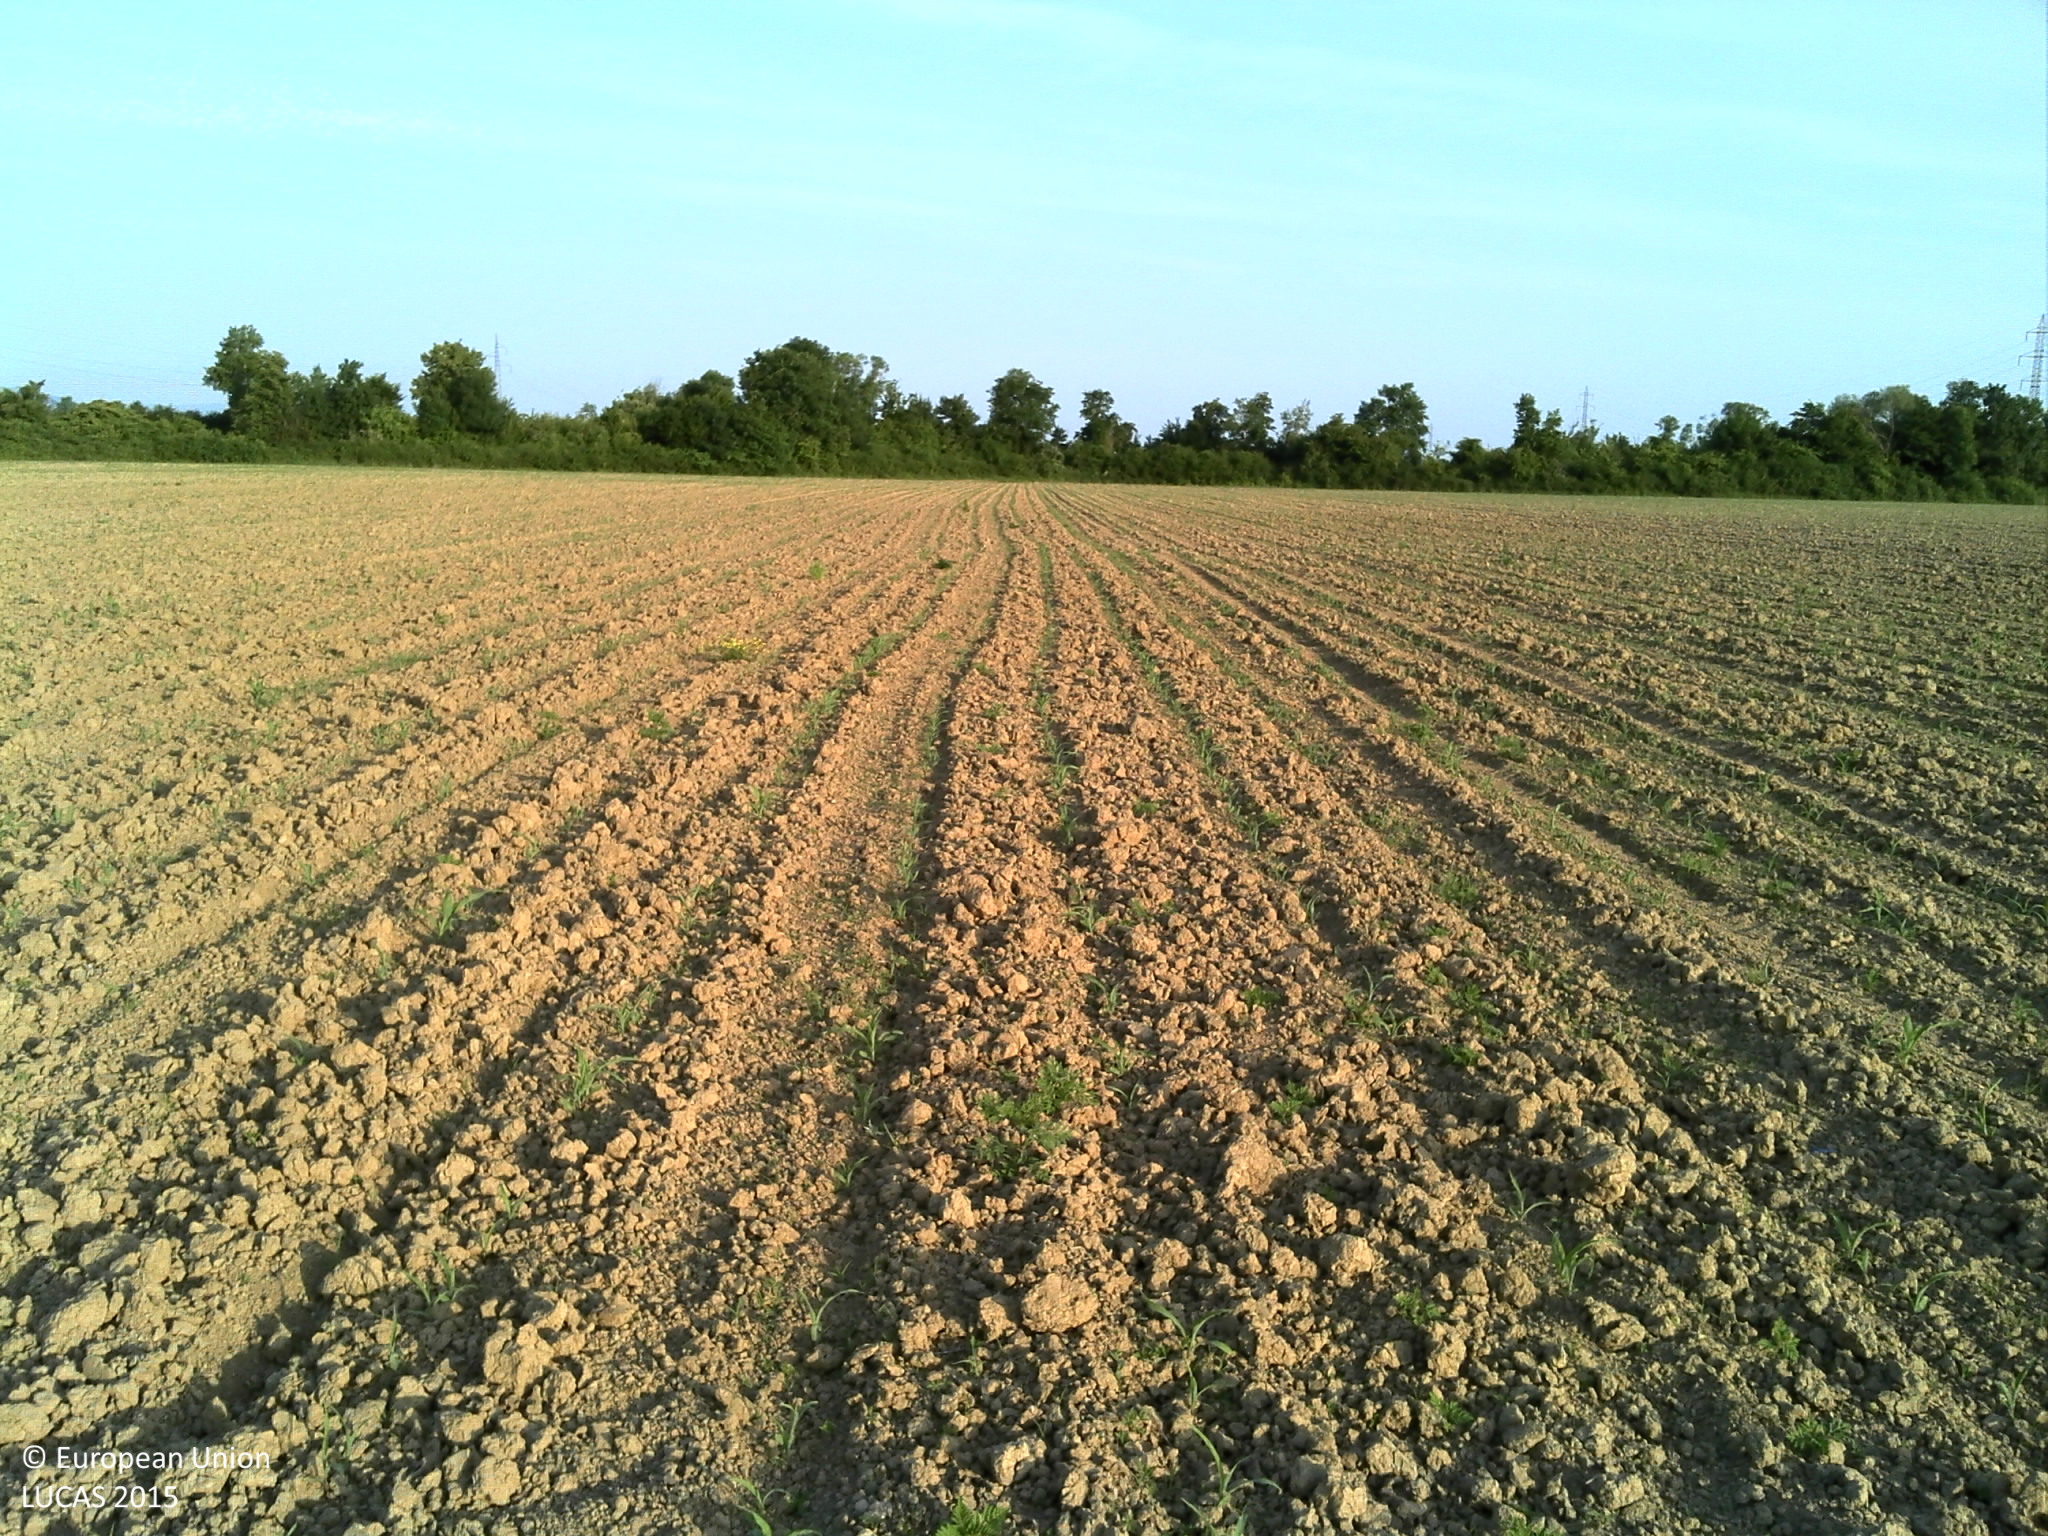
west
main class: Cropland
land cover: Maize
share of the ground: 10 - 25 %
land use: Agriculture (excluding fallow land and kitchen gardens)
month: May
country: HR
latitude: 45.4963
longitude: 18.1561
